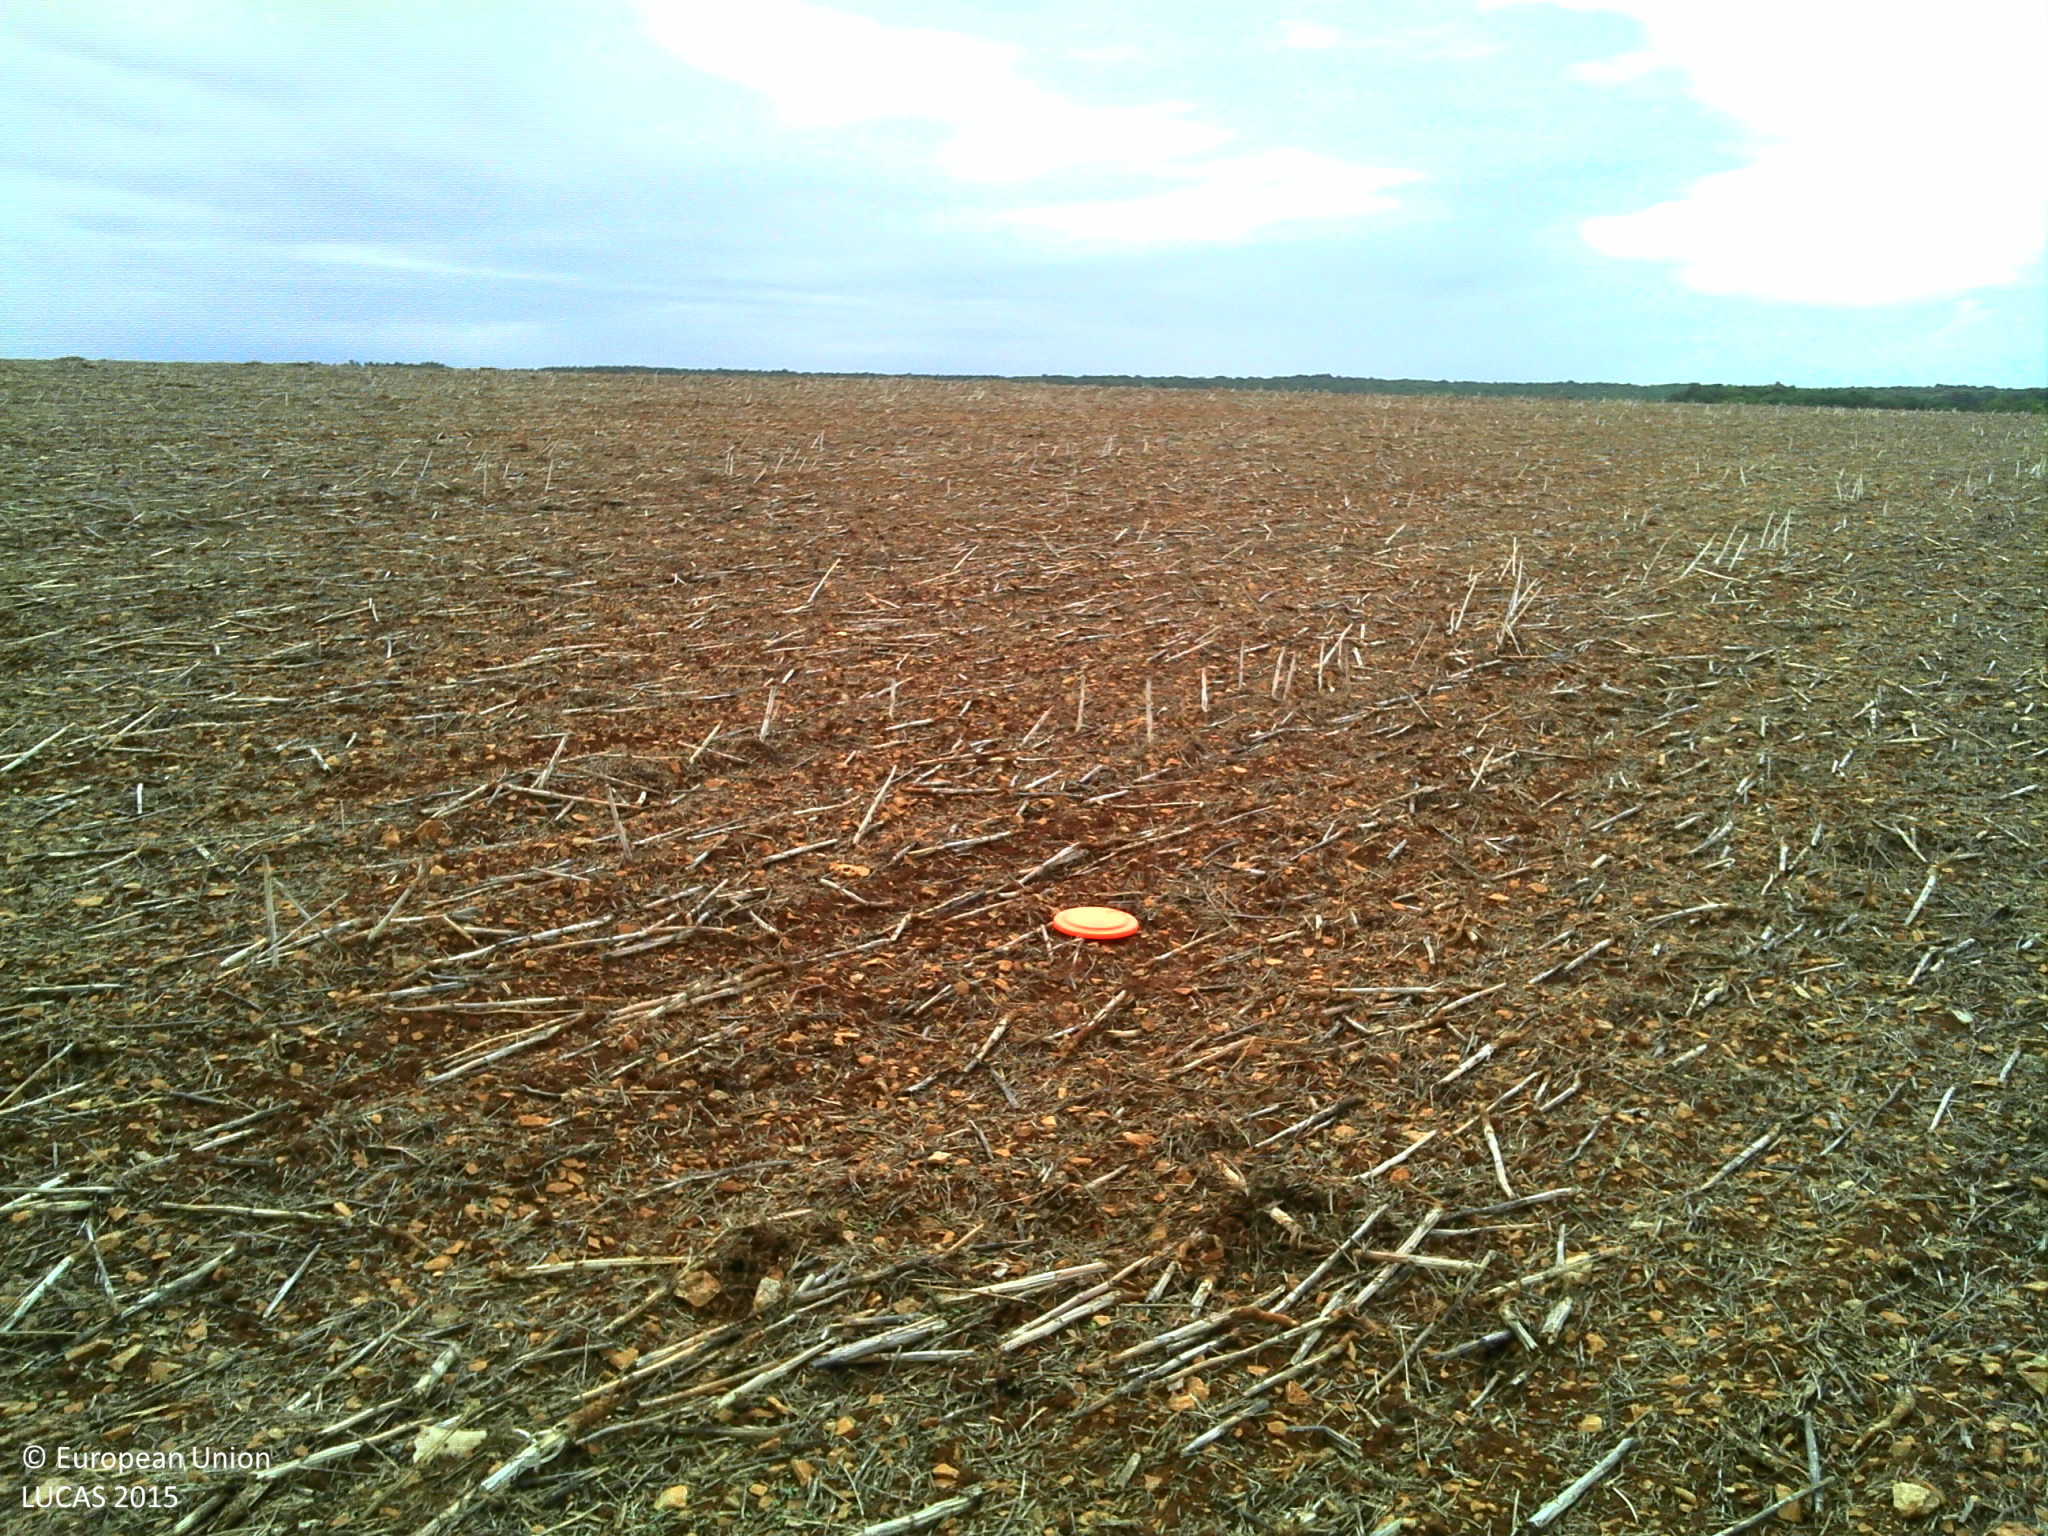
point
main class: Cropland
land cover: Rape and turnip rape
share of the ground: < 10 %
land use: Agriculture (excluding fallow land and kitchen gardens)
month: August
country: FR
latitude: 47.8997
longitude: 4.7417
